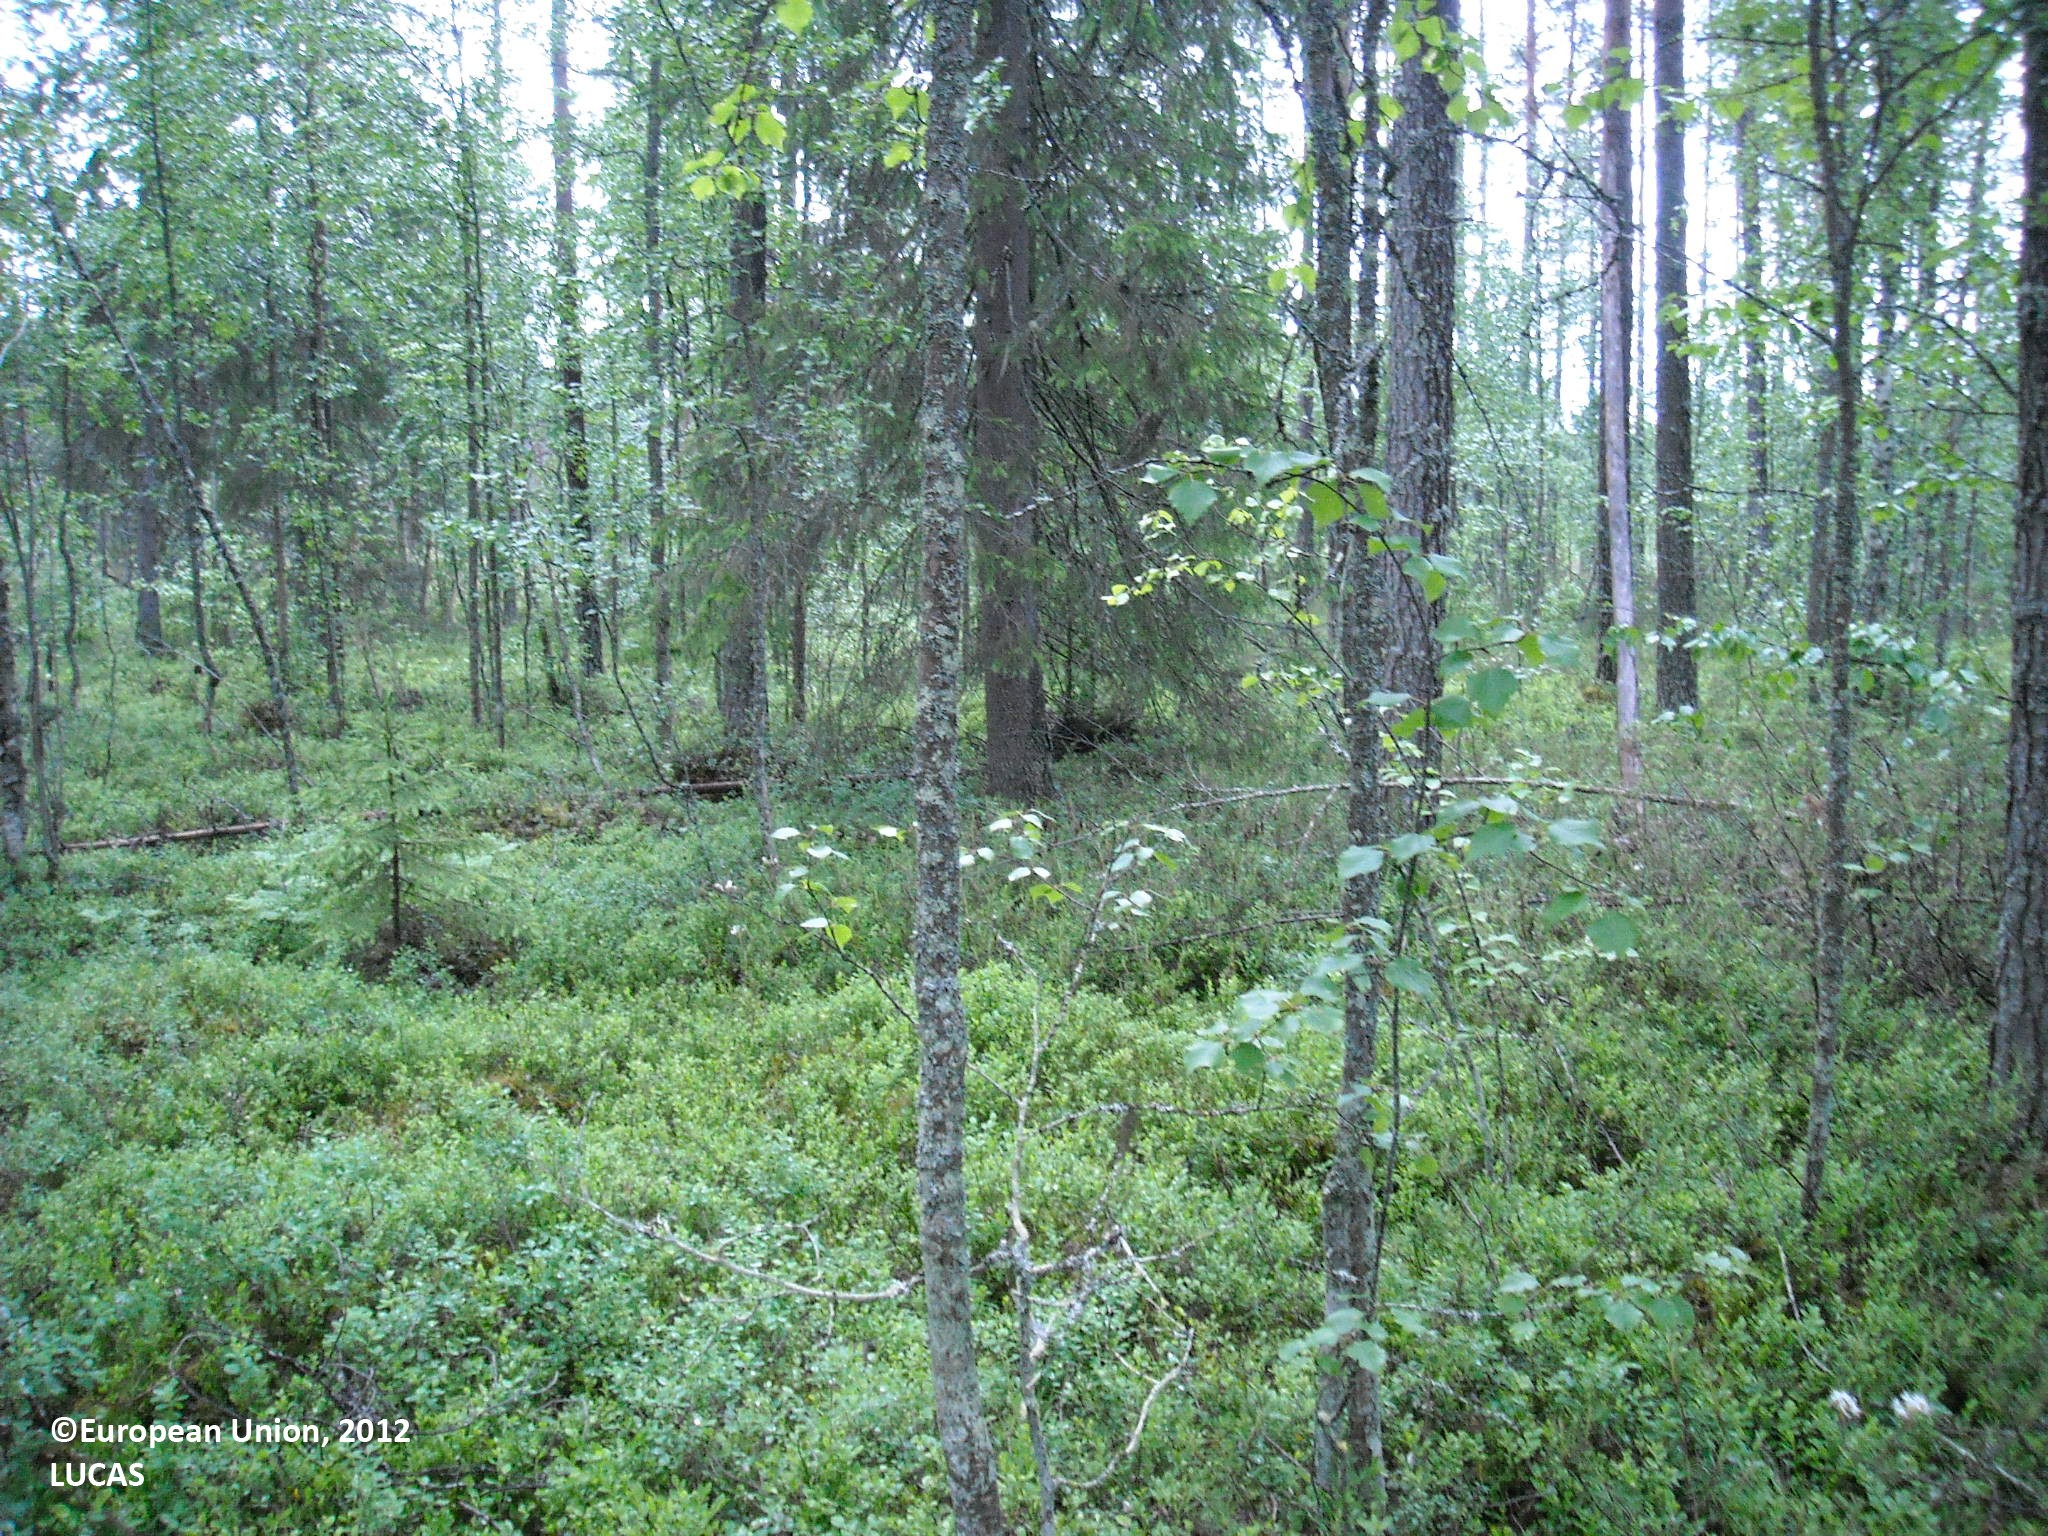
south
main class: Woodland
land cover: Pine dominated mixed woodland
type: boreal forest
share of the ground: > 75 %
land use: Forestry
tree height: > 5 m
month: July
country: FI
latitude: 65.0797
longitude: 28.0843
